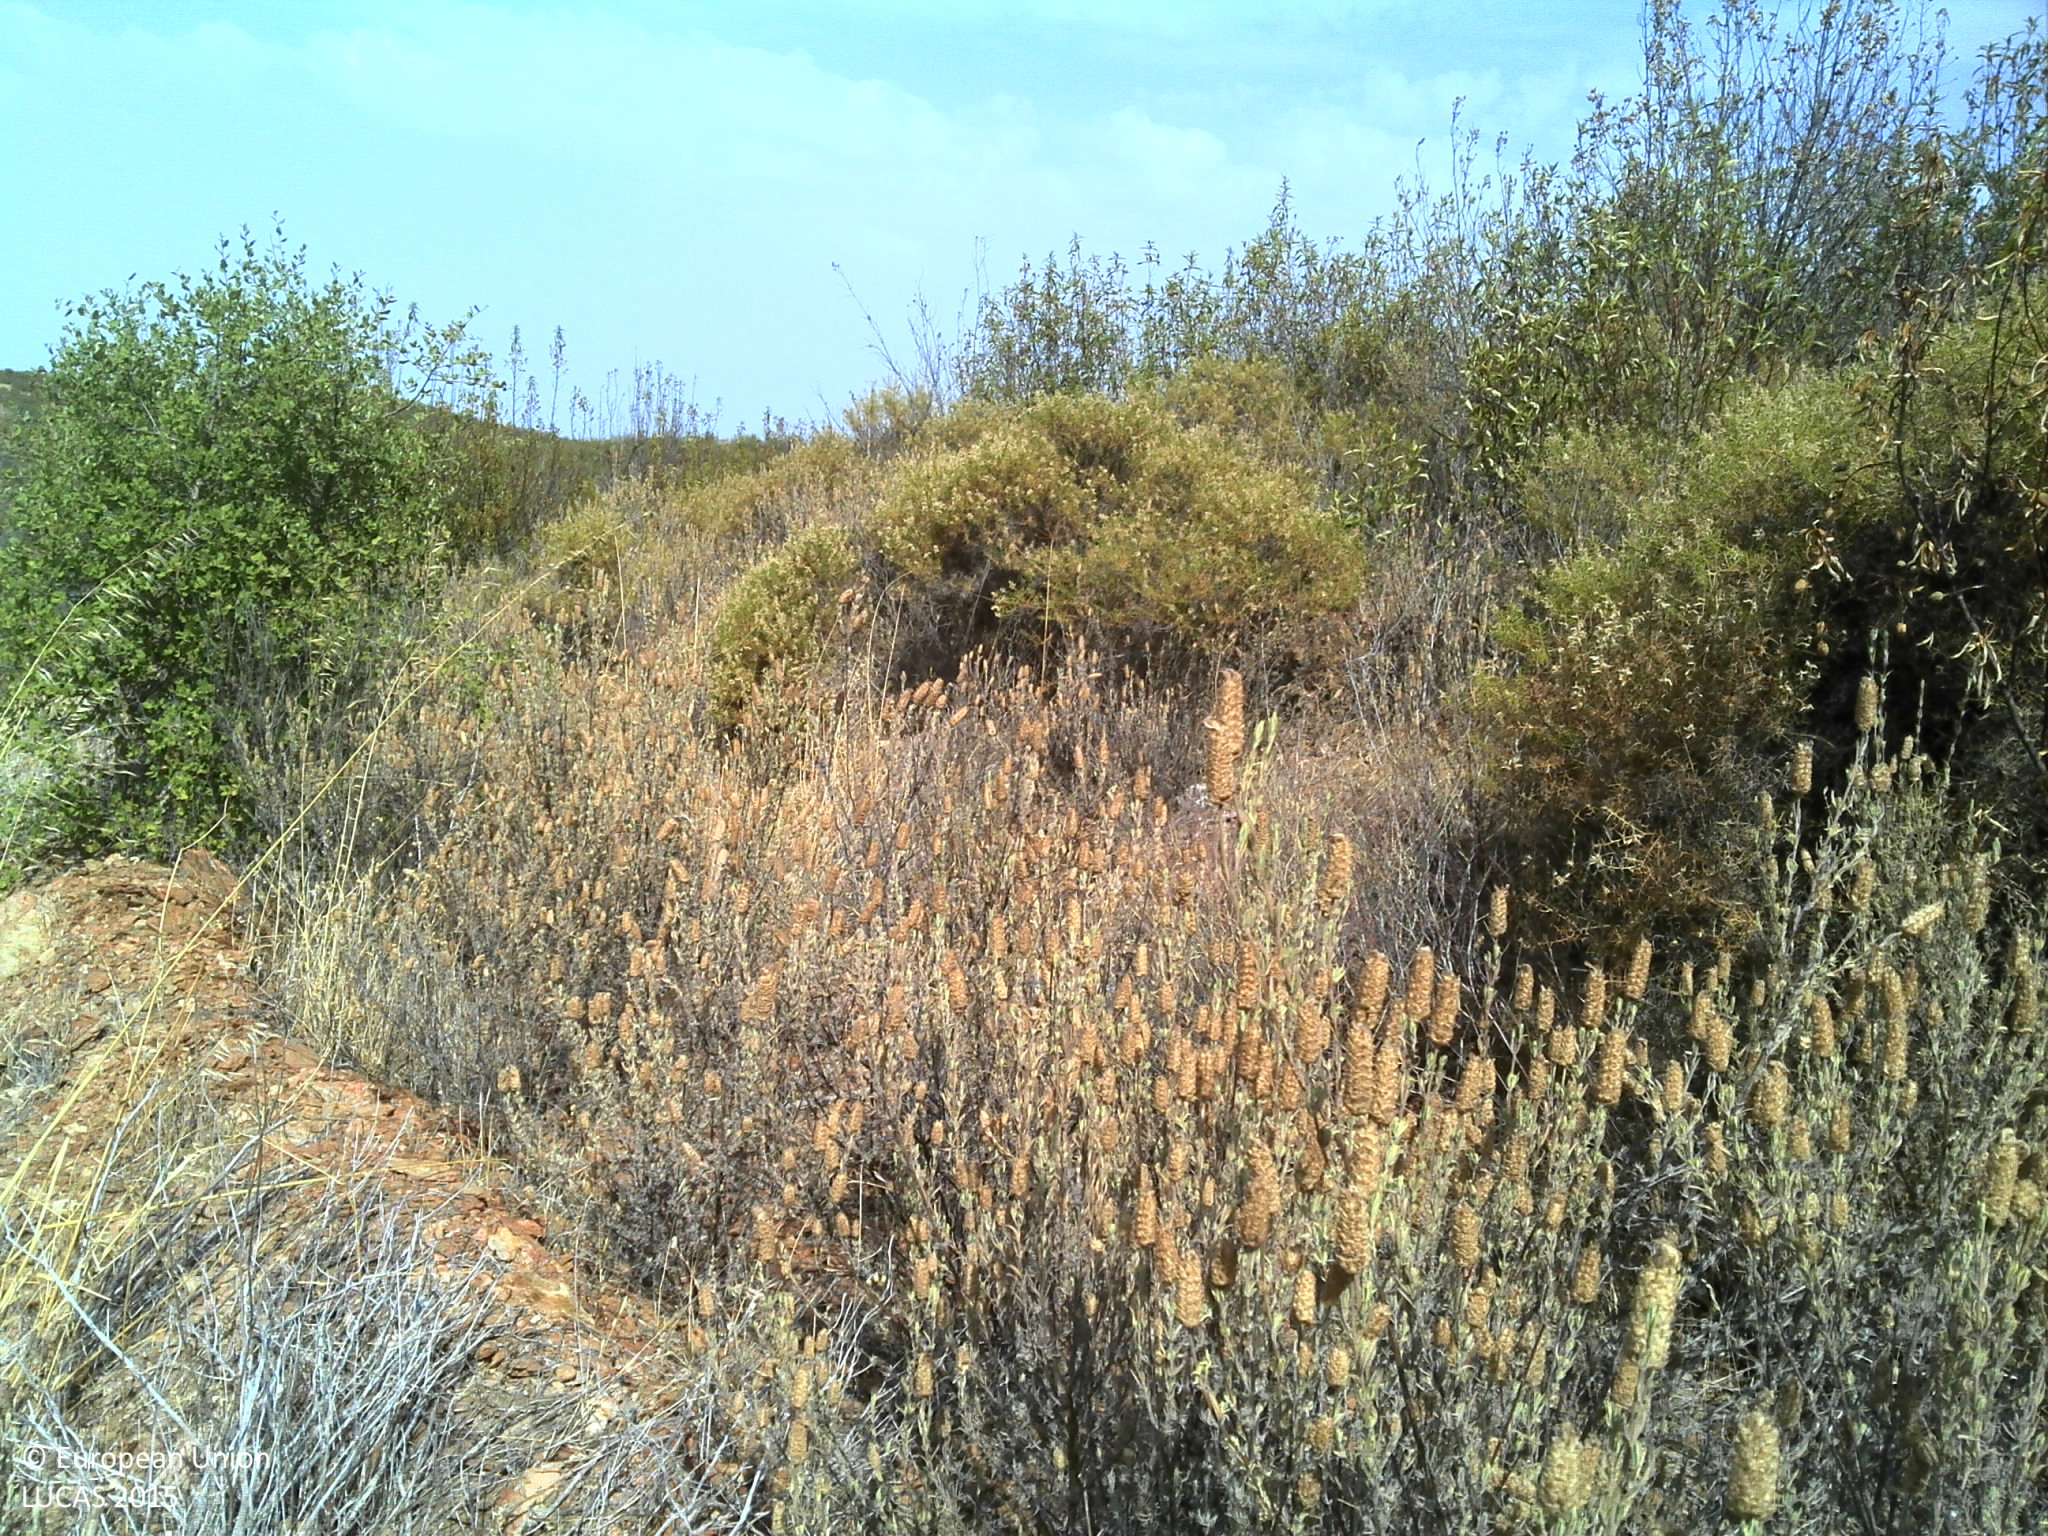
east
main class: Woodland
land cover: Broadleaved woodland
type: broadleaved evergreen forest
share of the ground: 10 - 25 %
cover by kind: broadleaved forest trees 25 %, shrubs 25 %, herbaceous plants 25 %, unconsolidated bare surface 25 %
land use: Forestry
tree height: < 5 m
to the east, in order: Broadleaved woodland; Tracks; Shrubland without tree cover; Shrubland with sparse tree cover; Rivers and streams; Shrubland with sparse tree cover; Tracks; Shrubland with sparse tree cover
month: July
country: PT
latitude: 37.8191
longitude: -7.6614
